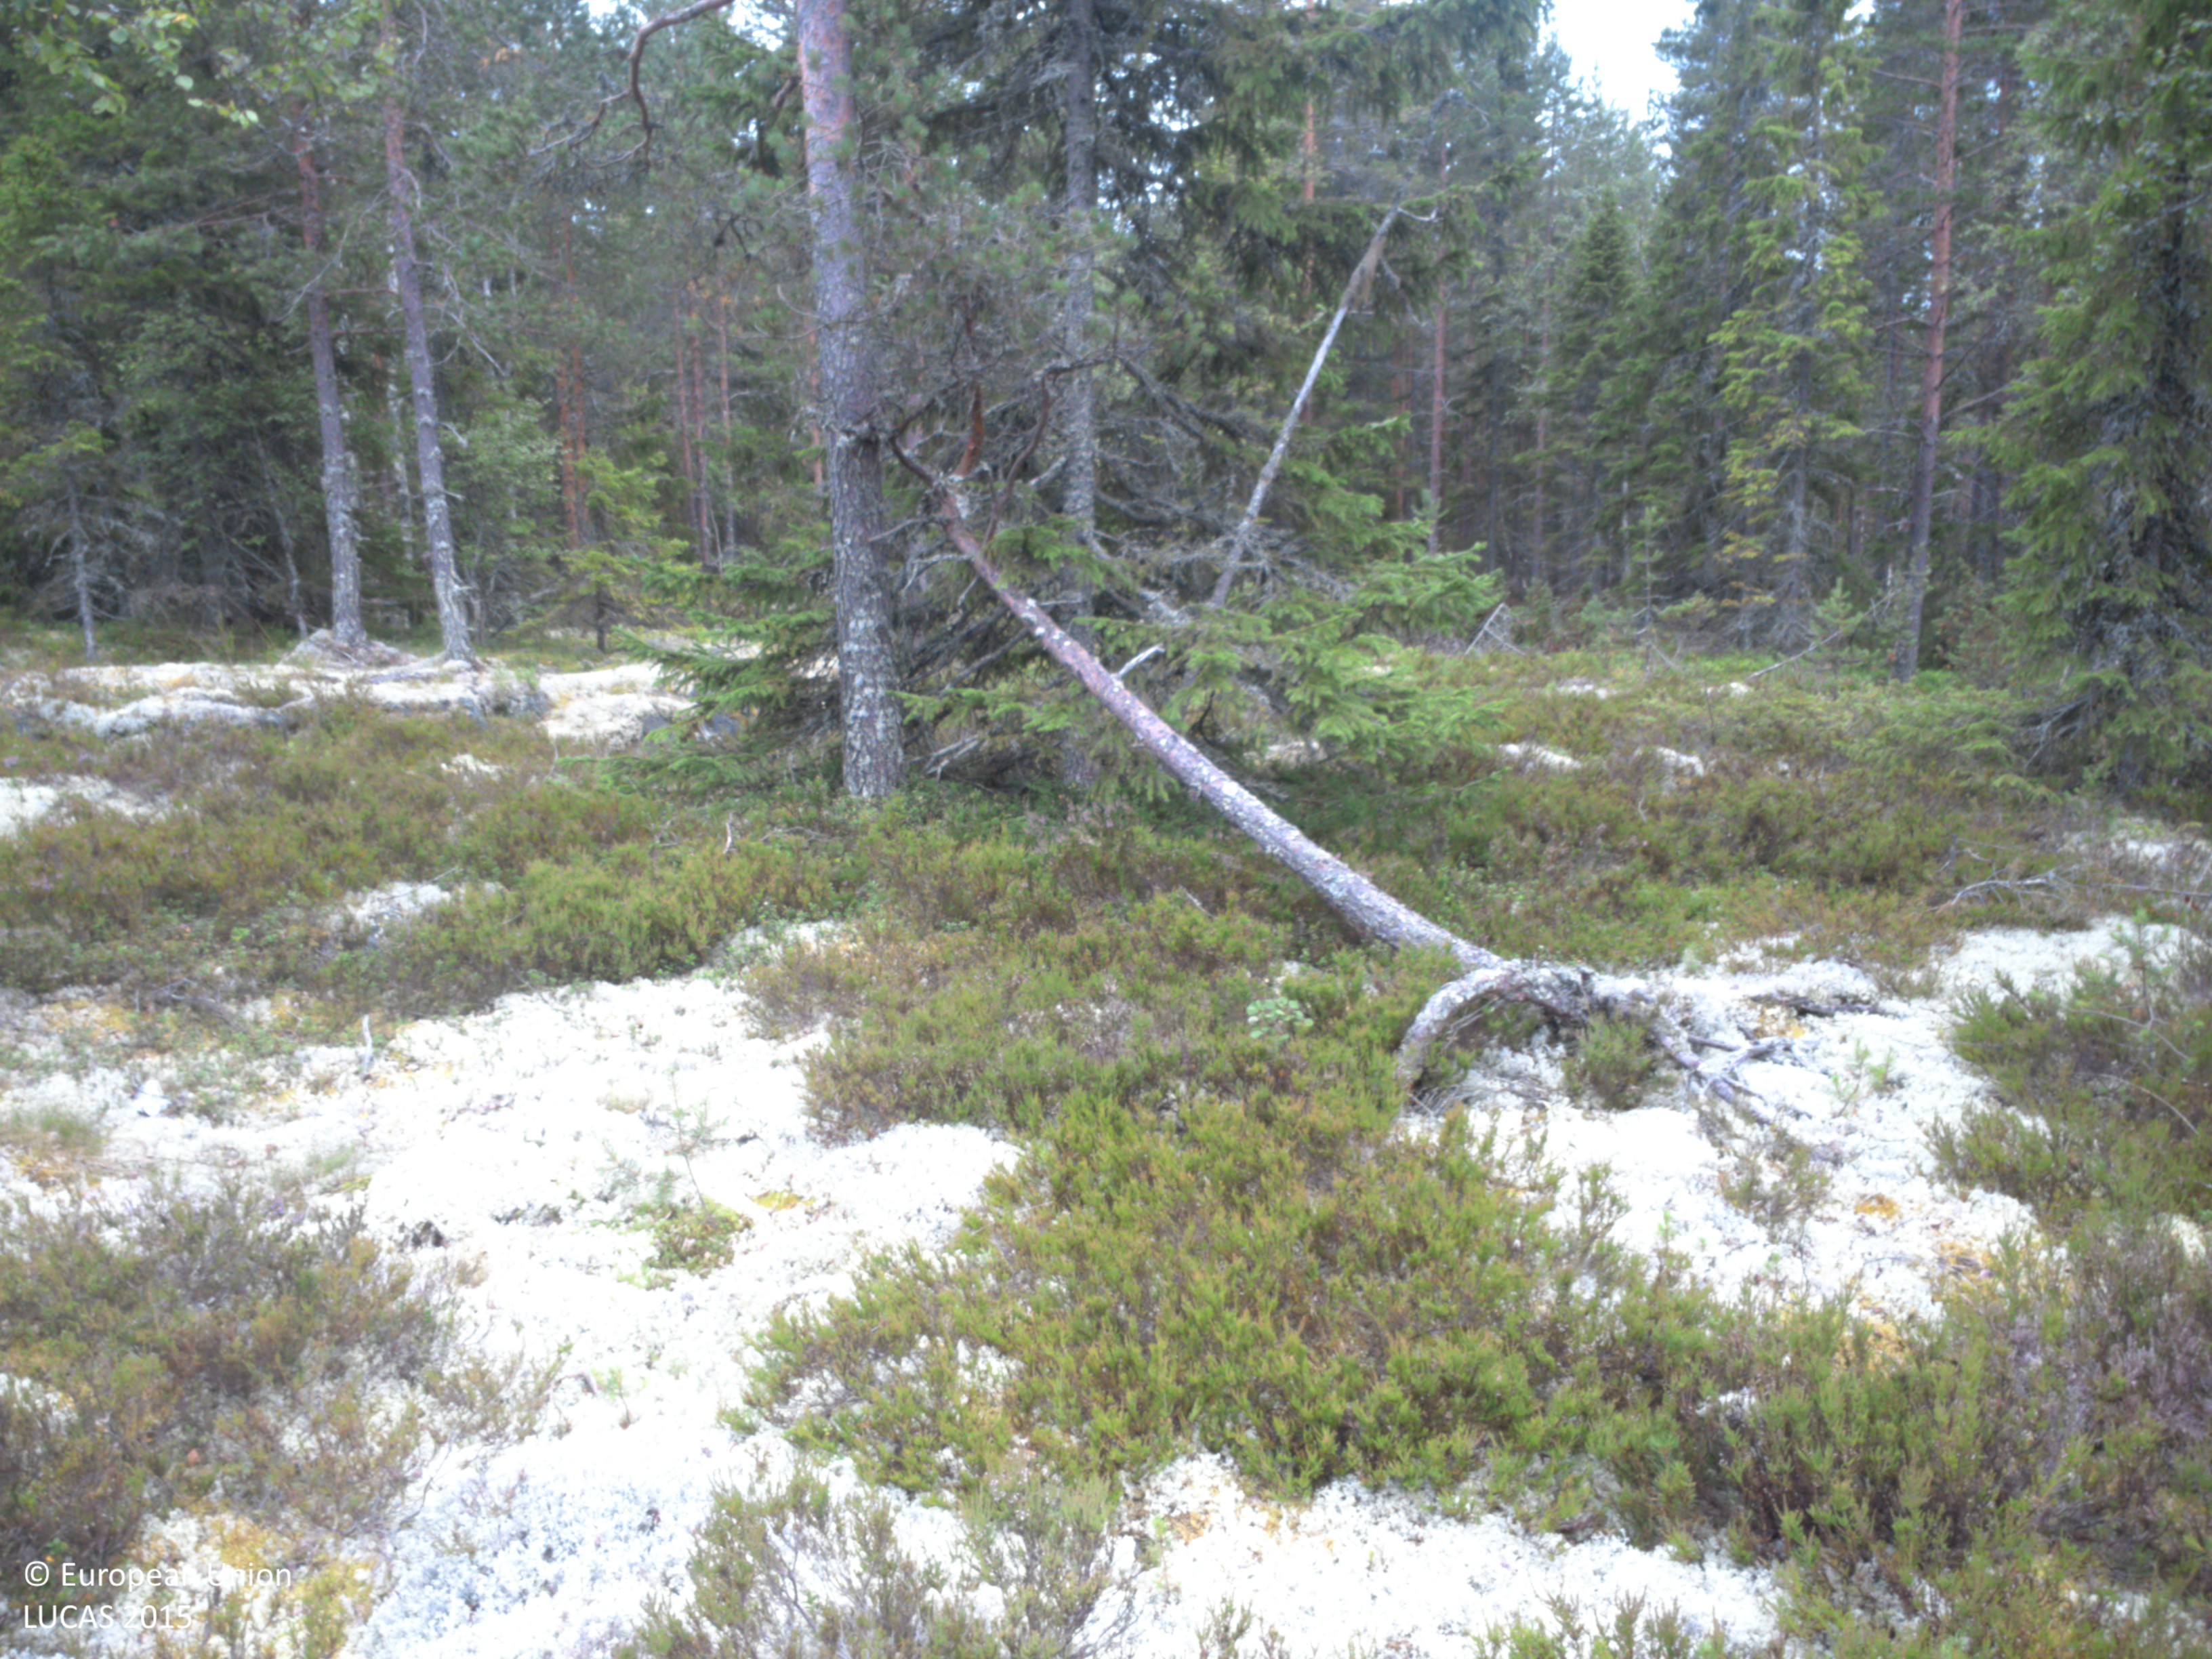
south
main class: Woodland
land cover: Pine dominated coniferous woodland
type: boreal forest
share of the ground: 25 - 50 %
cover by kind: lichens and mosses 50 %, coniferous forest trees 25 %, shrubs 20 %, broadleaved forest trees 5 %
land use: Forestry
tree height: > 5 m
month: August
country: SE
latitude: 63.6816
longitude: 19.7037
